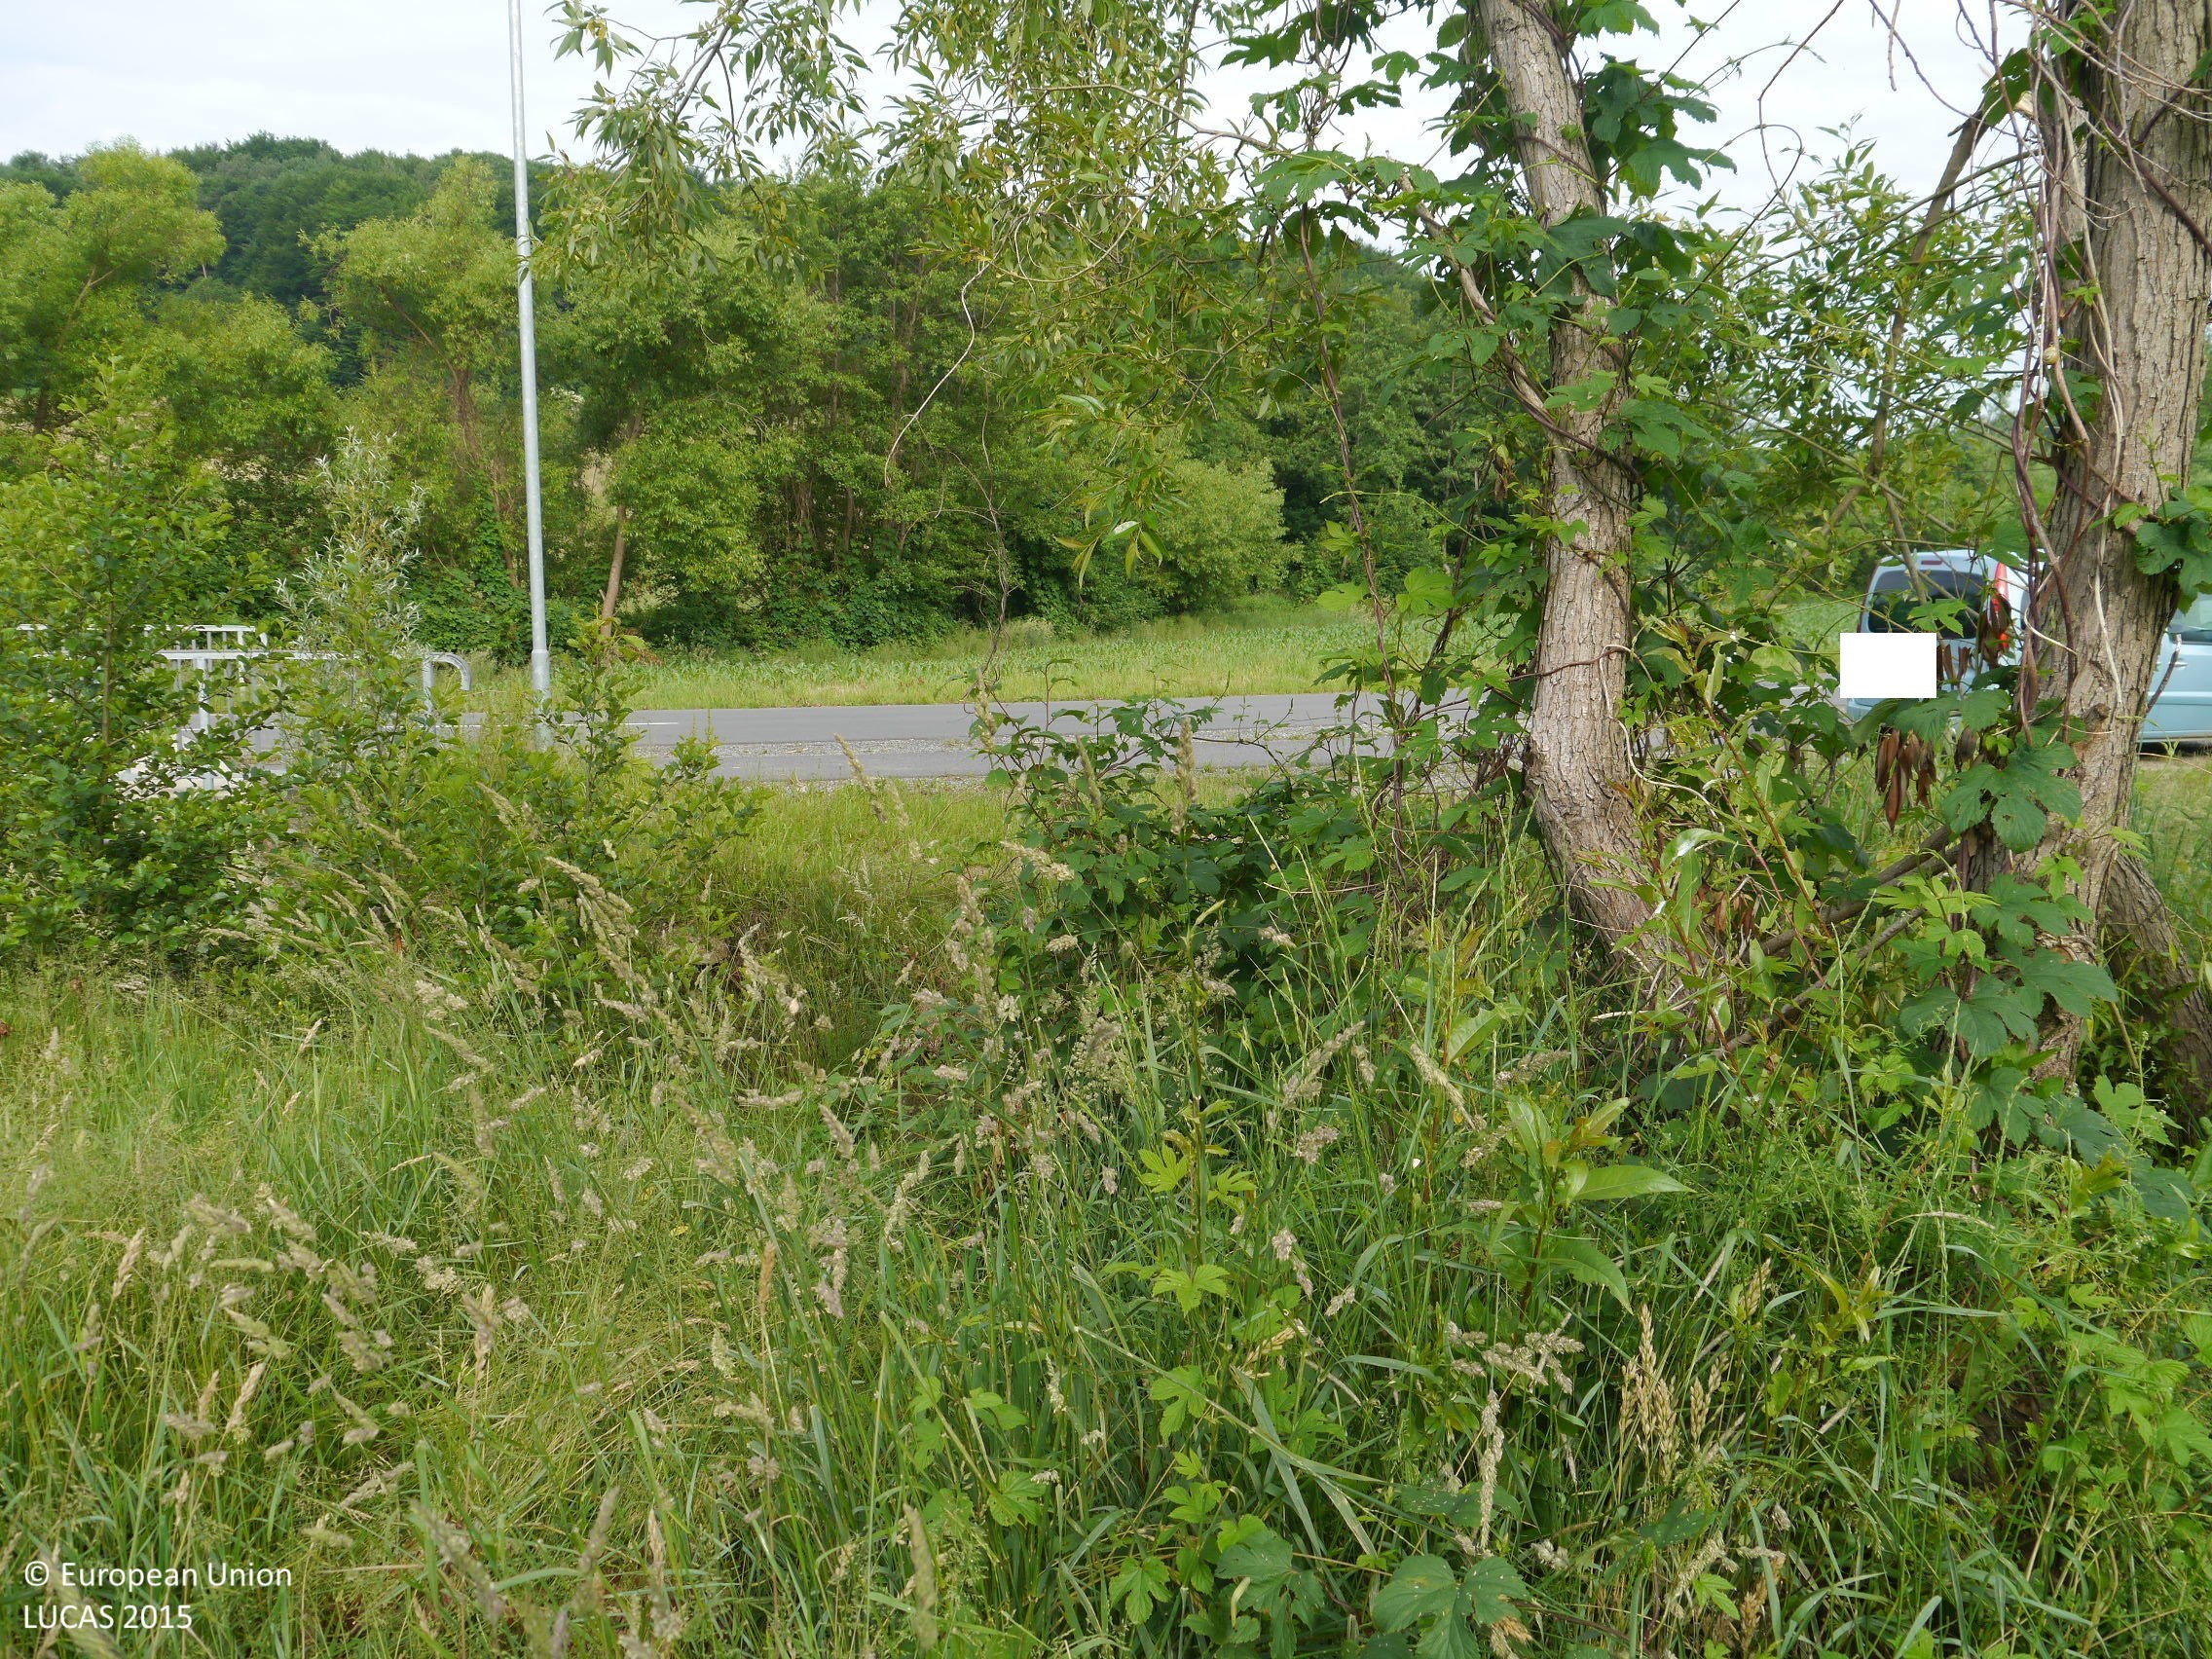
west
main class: Grassland
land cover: Grassland without tree/shrub cover
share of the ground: > 75 %
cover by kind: herbaceous plants 100 %
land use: Agriculture (excluding fallow land and kitchen gardens)
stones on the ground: < 10 %
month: June
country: AT
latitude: 46.9386
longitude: 15.7144
